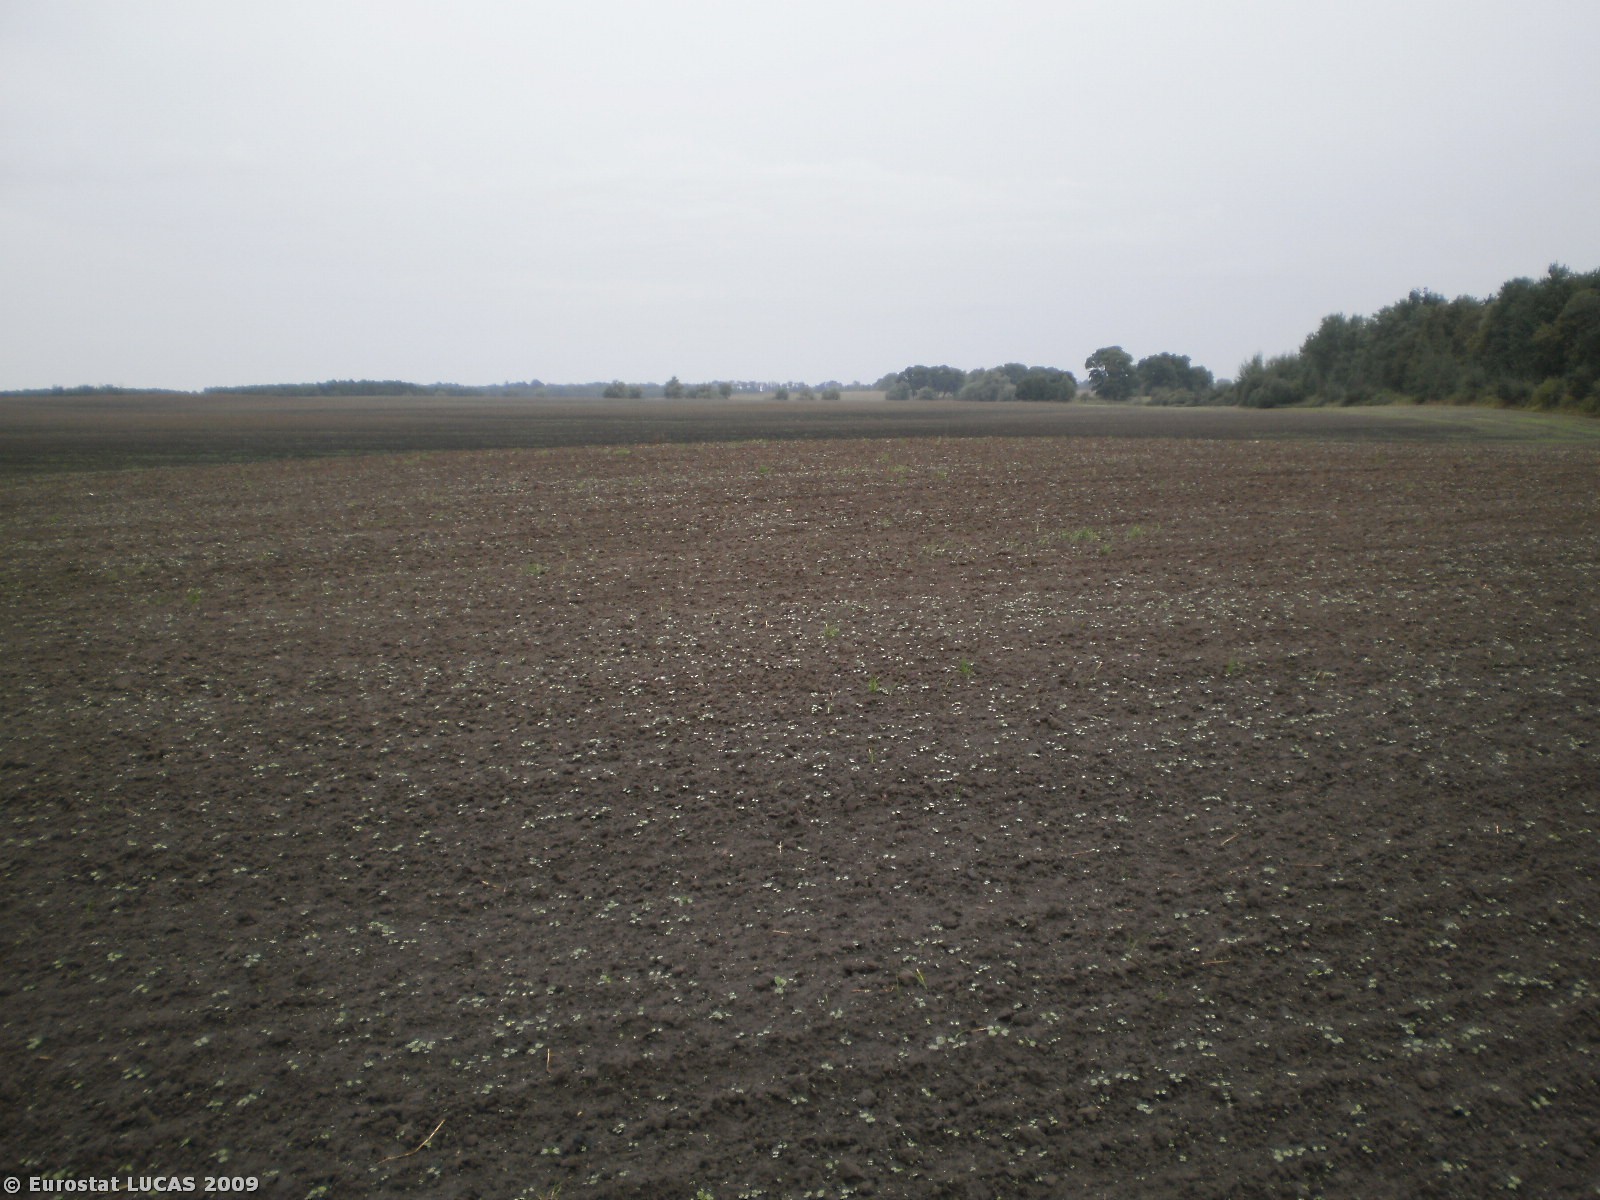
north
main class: Cropland
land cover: Common wheat
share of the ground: < 10 %
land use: Agriculture (excluding fallow land and kitchen gardens)
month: August
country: PL
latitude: 54.2723
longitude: 21.2710
